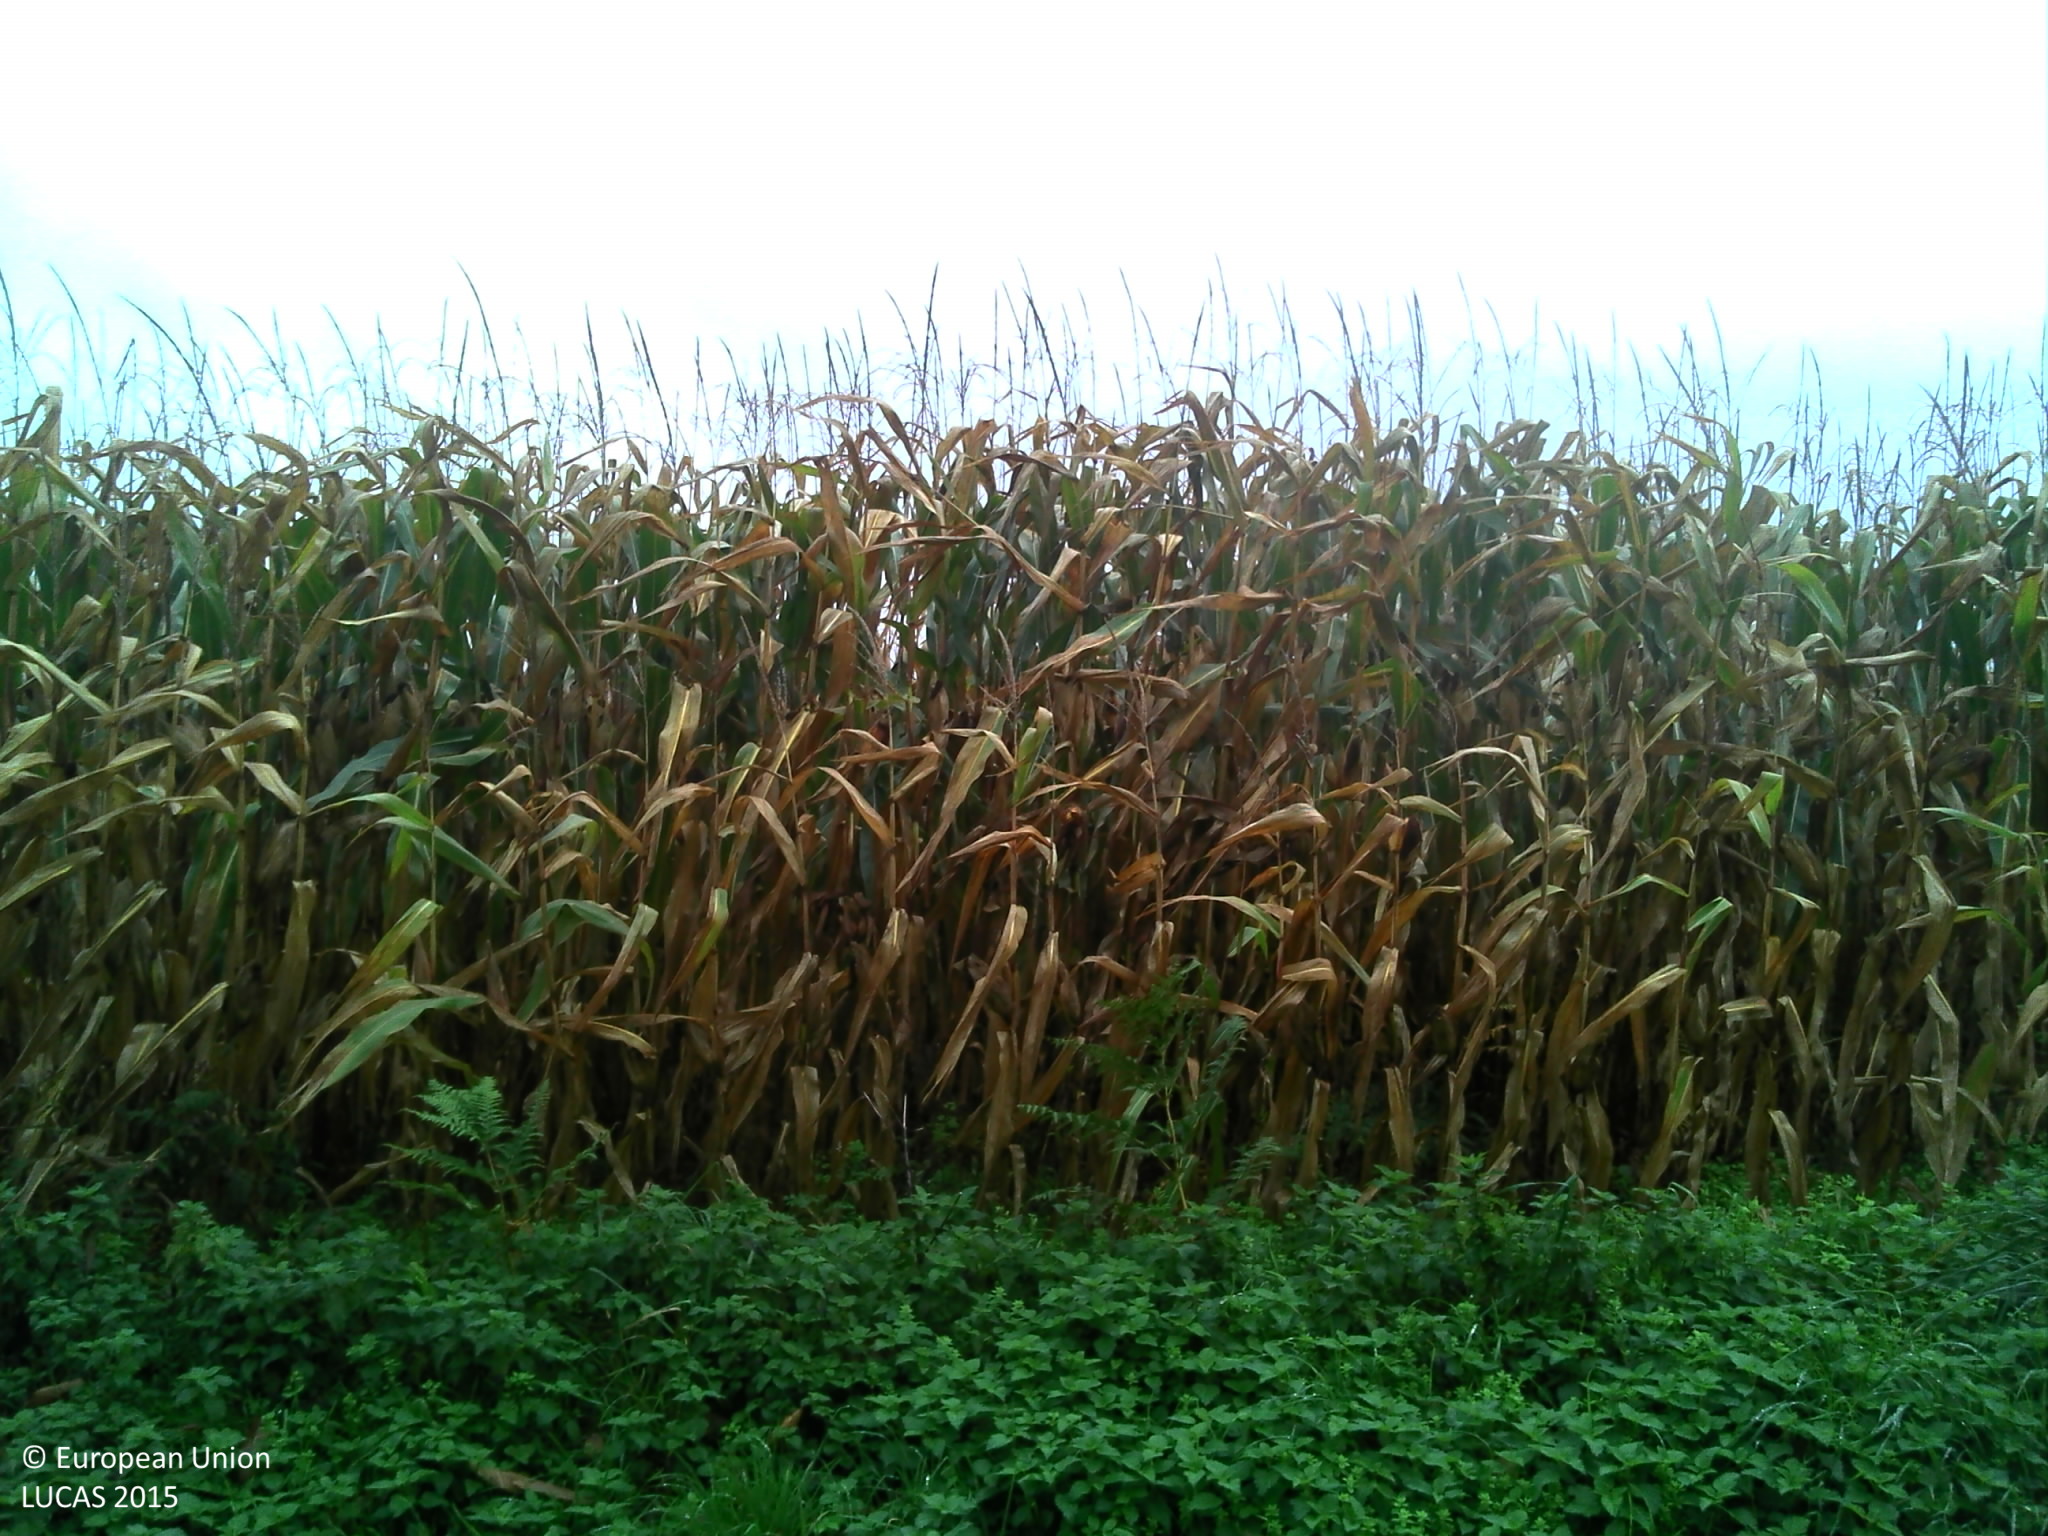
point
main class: Cropland
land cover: Maize
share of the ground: > 75 %
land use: Agriculture (excluding fallow land and kitchen gardens)
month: November
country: FR
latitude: 47.9725
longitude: -3.0487
